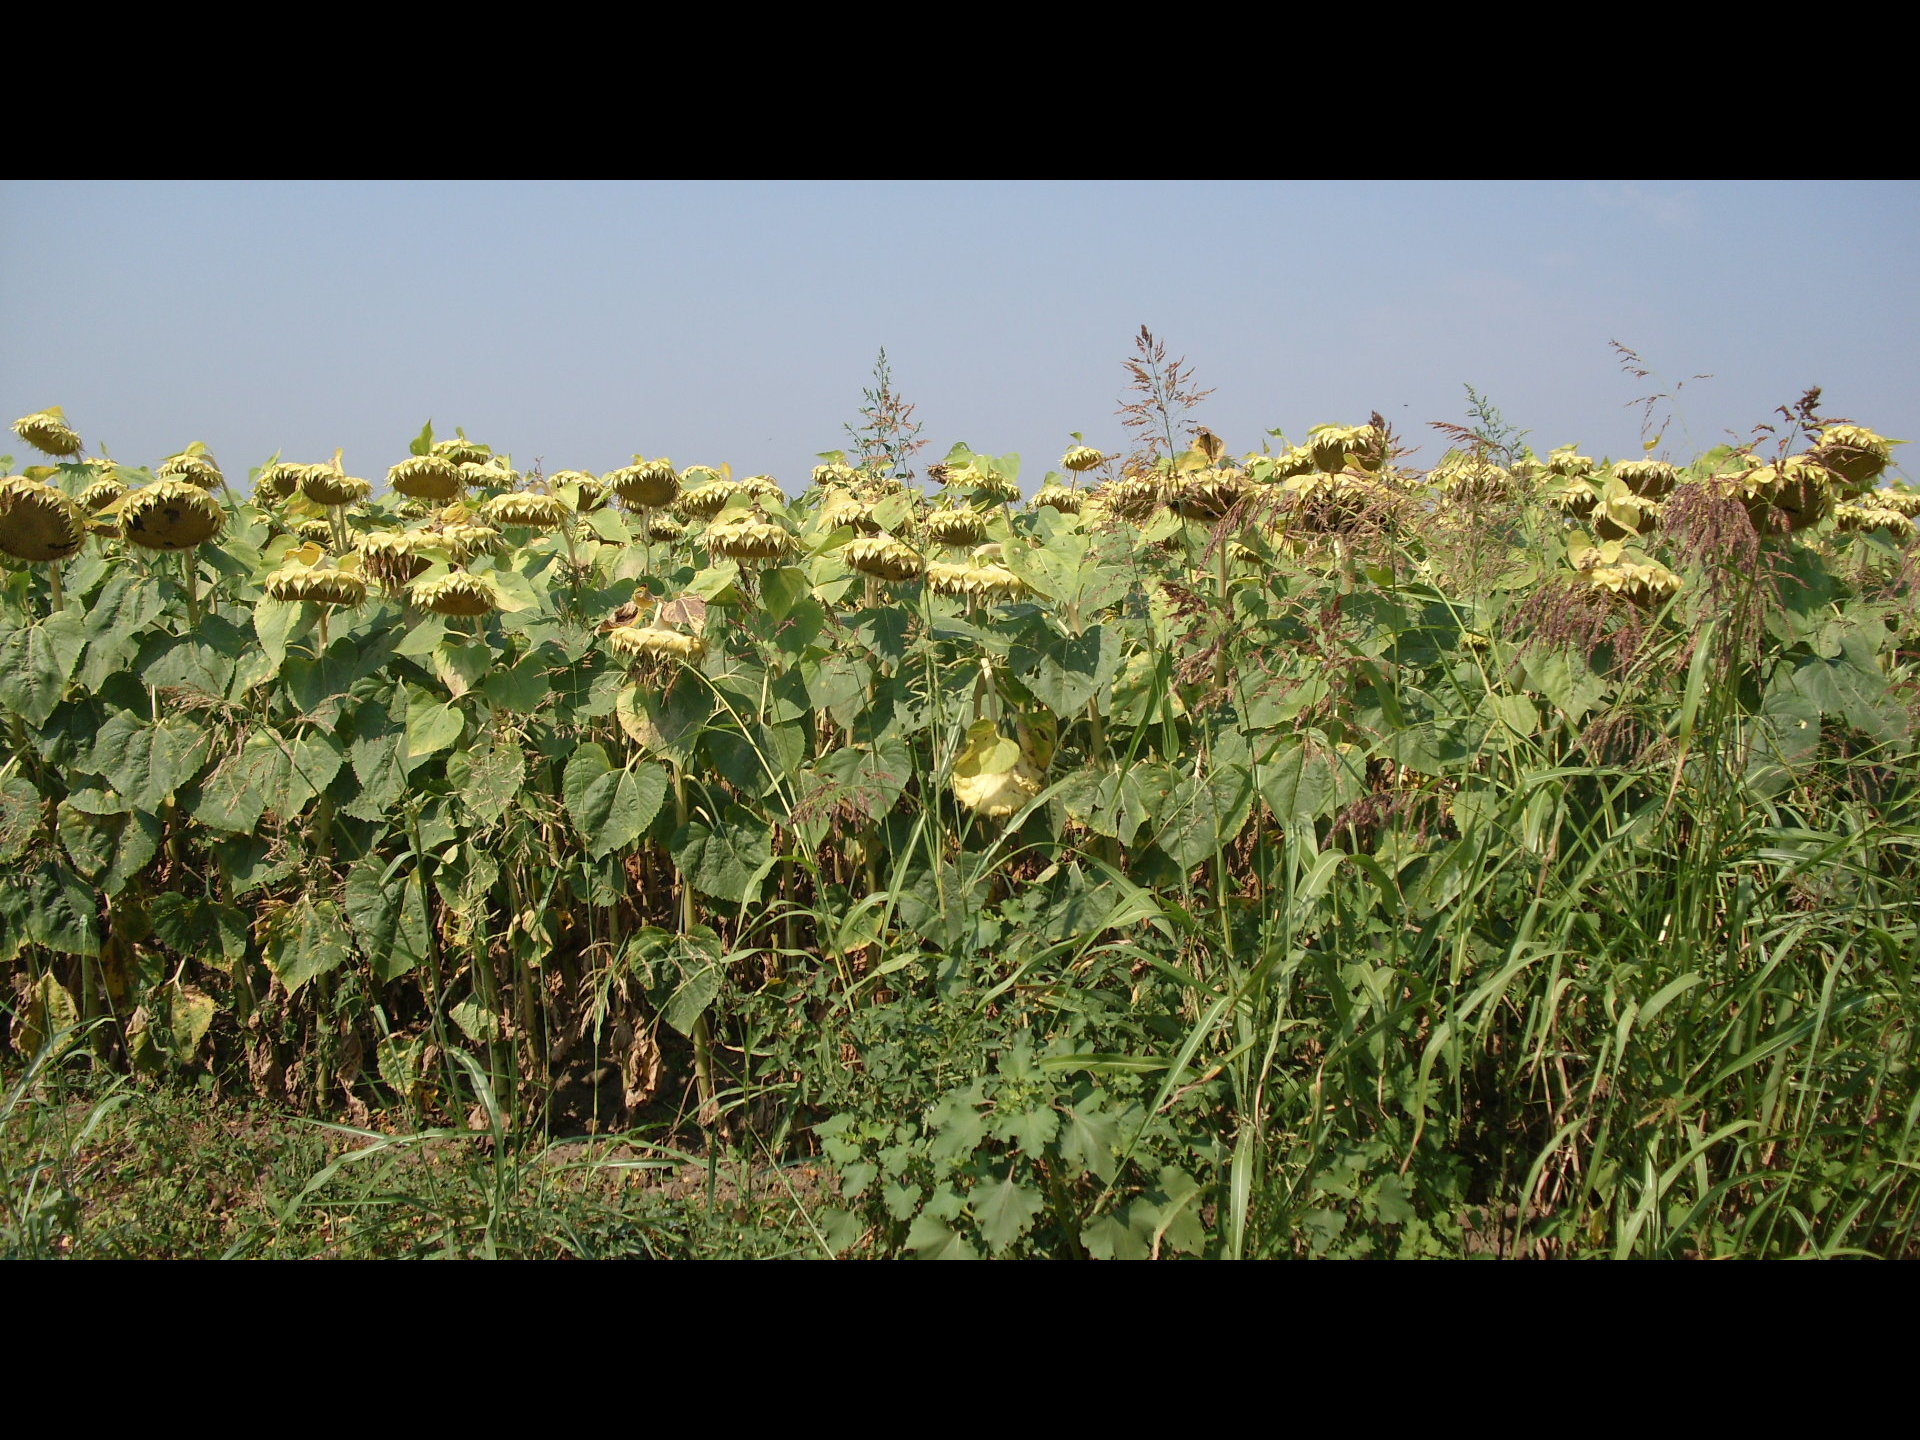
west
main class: Cropland
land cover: Sunflower
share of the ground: > 75 %
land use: Agriculture (excluding fallow land and kitchen gardens)
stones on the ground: < 10 %
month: July
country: BG
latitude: 43.7531
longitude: 23.5224
